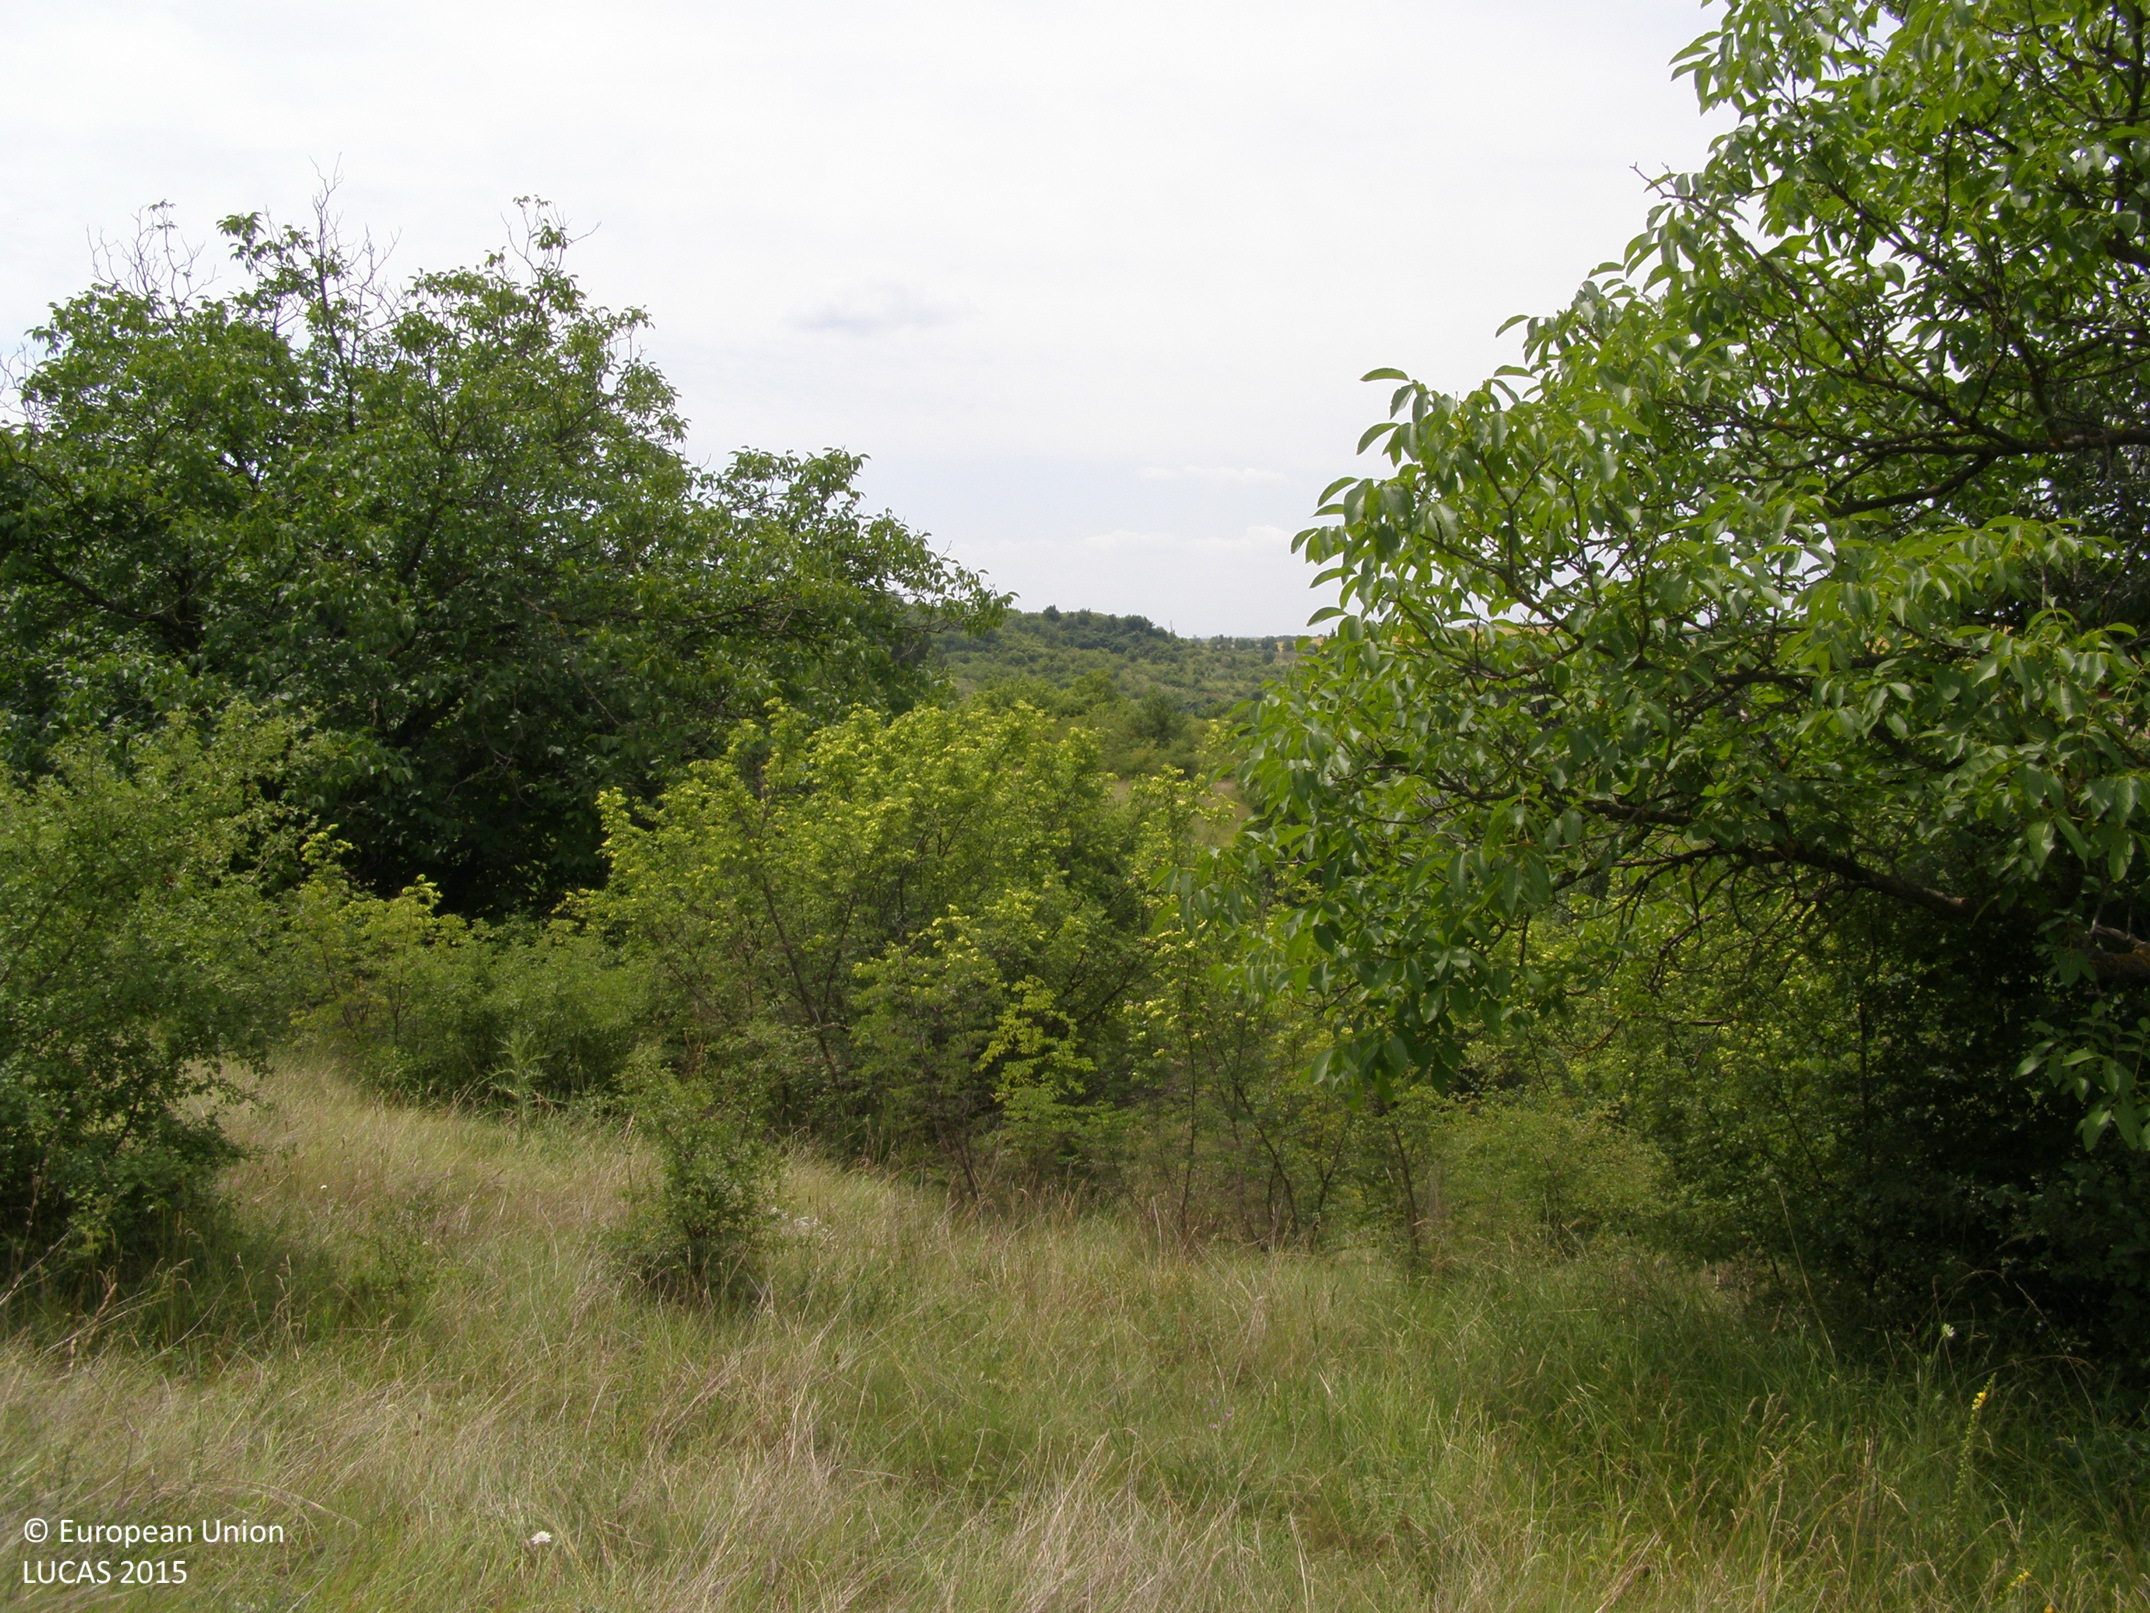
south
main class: Grassland
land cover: Grassland with sparse tree/shrub cover
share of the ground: > 75 %
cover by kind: herbaceous plants 85 %, shrubs 10 %, broadleaved forest trees 5 %
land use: Abandoned areas
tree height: < 5 m
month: July
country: BG
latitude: 43.2668
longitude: 27.1069
